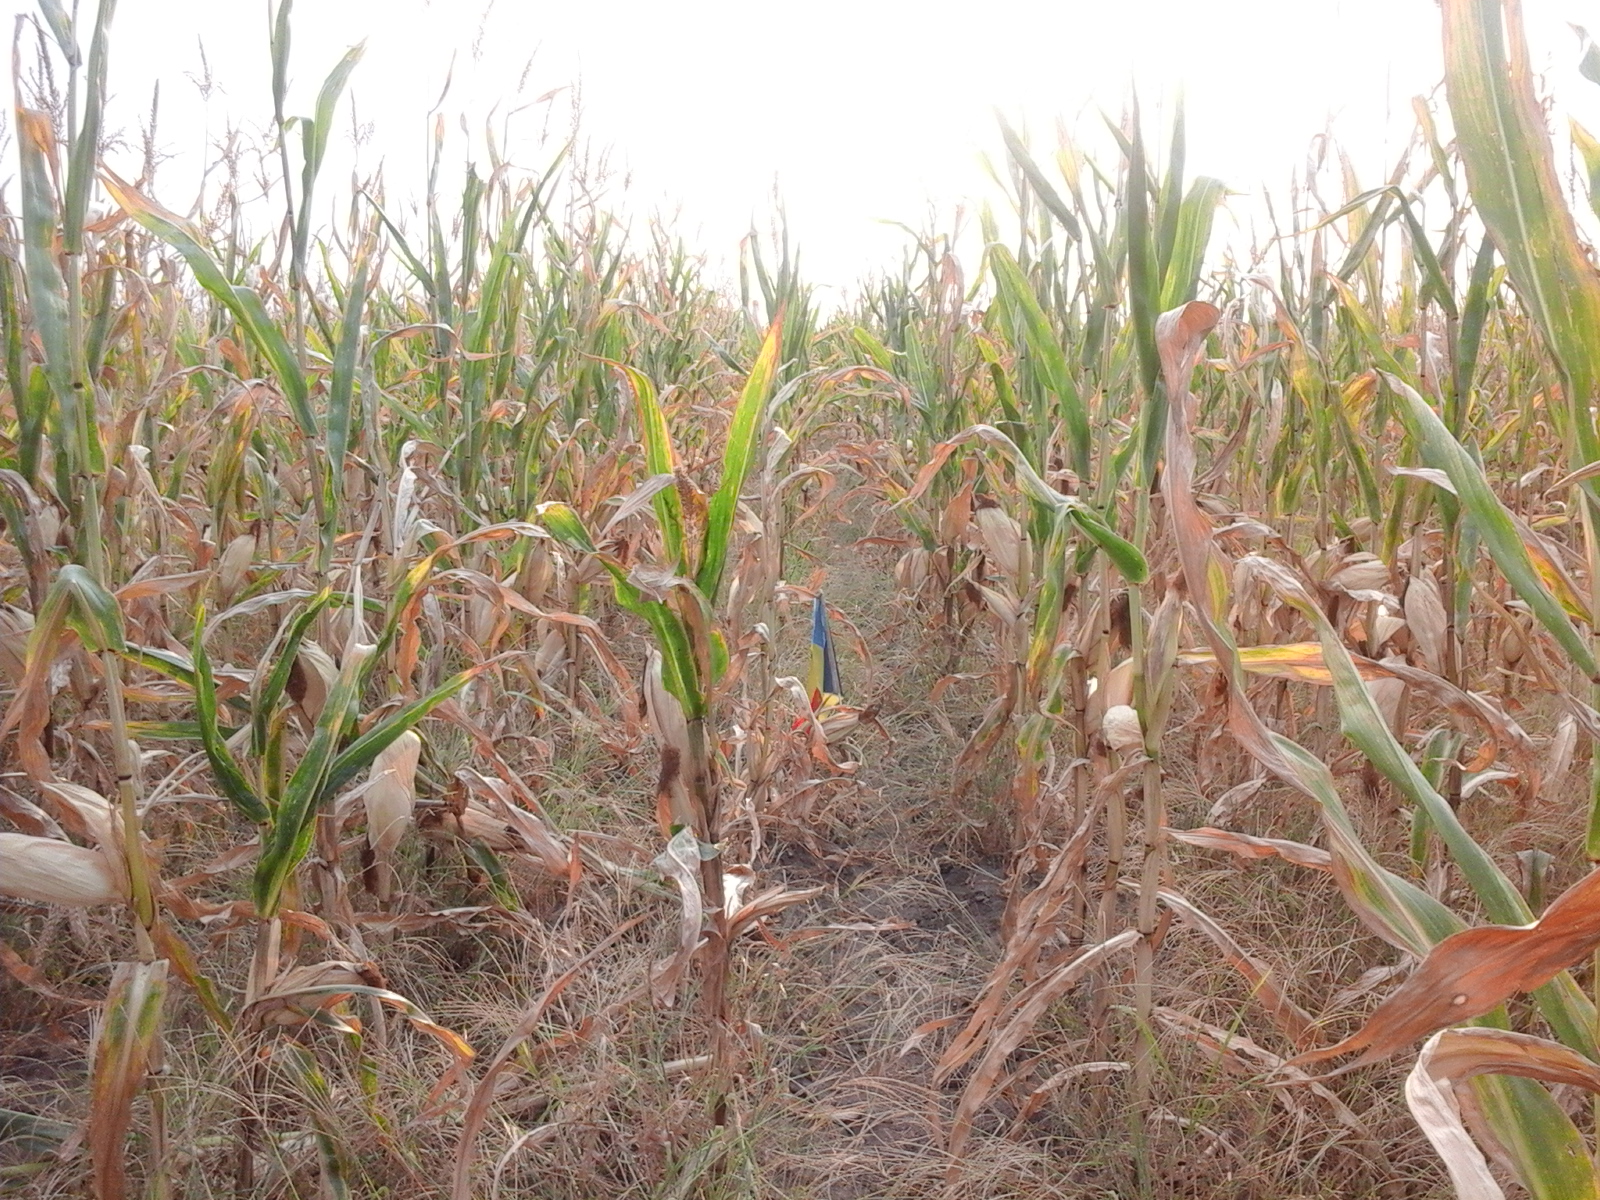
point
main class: Cropland
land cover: Maize
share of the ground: > 75 %
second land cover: Spontaneously vegetated surfaces
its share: > 75 %
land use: Agriculture (excluding fallow land and kitchen gardens)
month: August
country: RO
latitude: 44.0574
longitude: 23.2907
